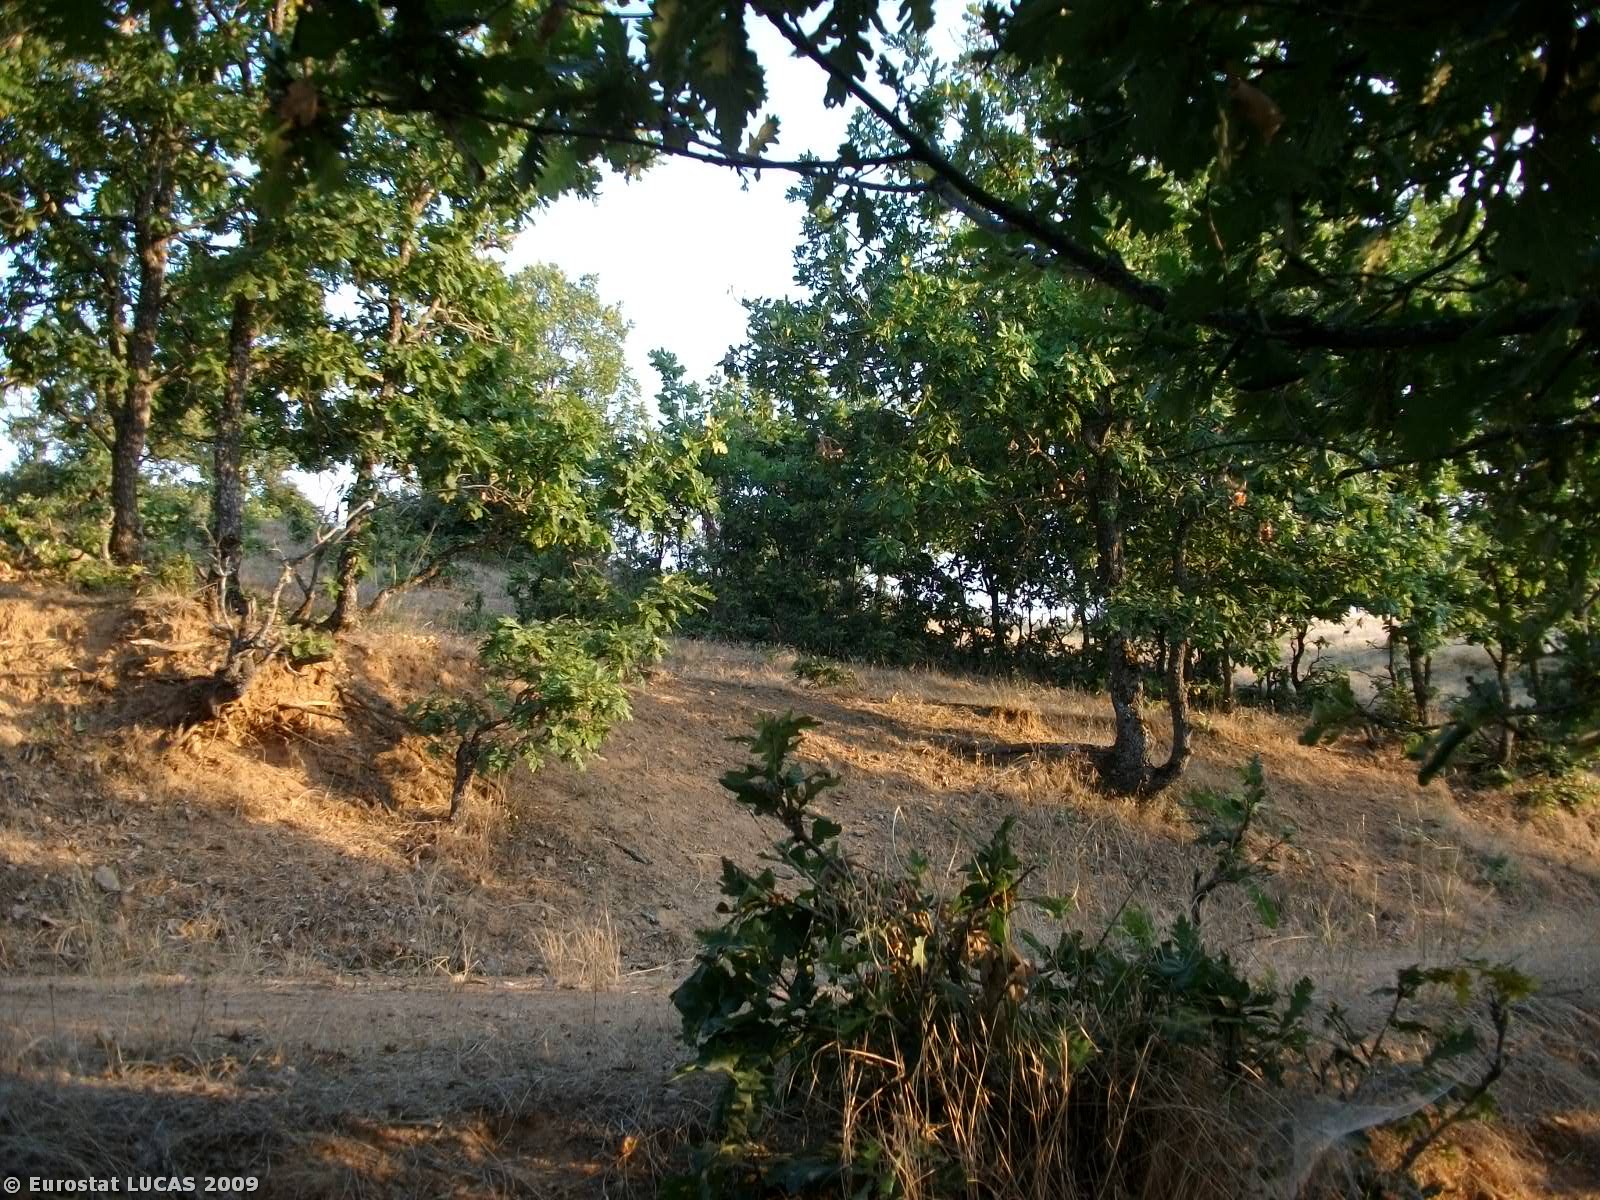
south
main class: Woodland
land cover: Broadleaved woodland
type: thermophilous deciduous forest
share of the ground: > 75 %
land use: Forestry
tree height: > 5 m
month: July
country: GR
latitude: 39.8502
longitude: 21.7562
